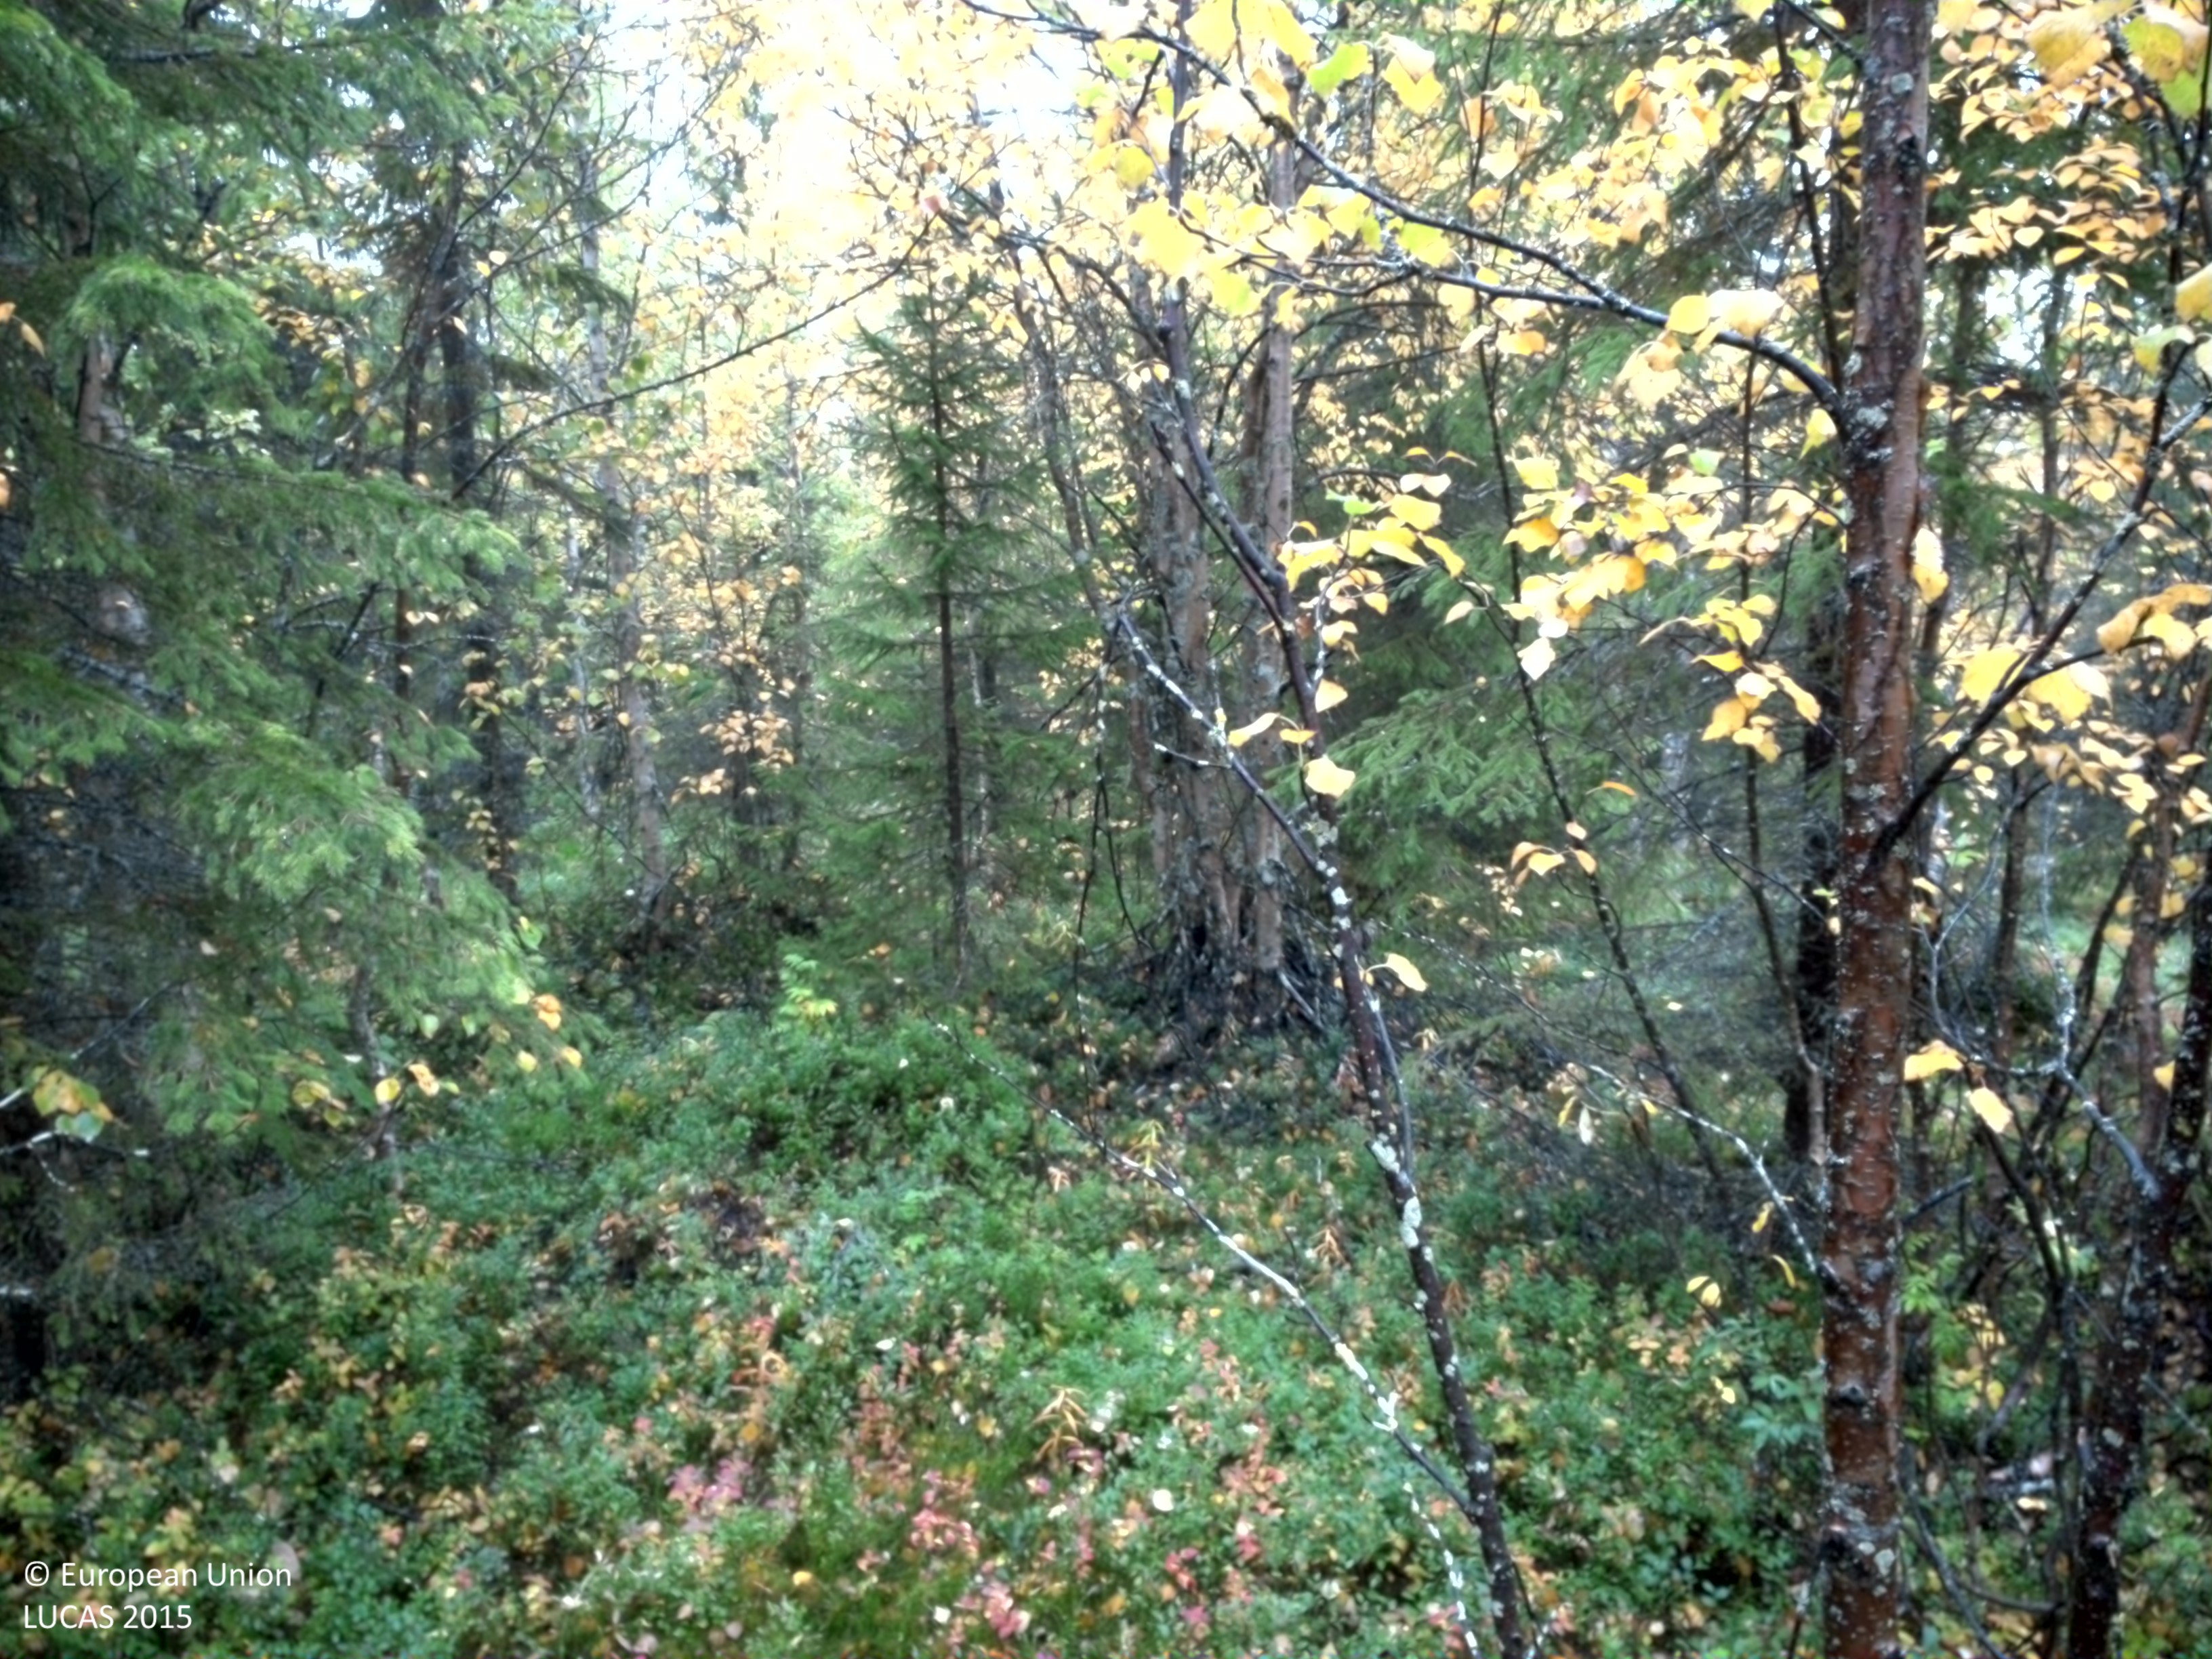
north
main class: Woodland
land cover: Spruce dominated mixed woodland
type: boreal forest
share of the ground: 50 - 75 %
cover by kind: coniferous forest trees 40 %, shrubs 25 %, broadleaved forest trees 20 %, herbaceous plants 10 %, lichens and mosses 5 %
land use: Forestry
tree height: > 5 m
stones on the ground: < 10 %
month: September
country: SE
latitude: 65.2332
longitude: 16.3174
